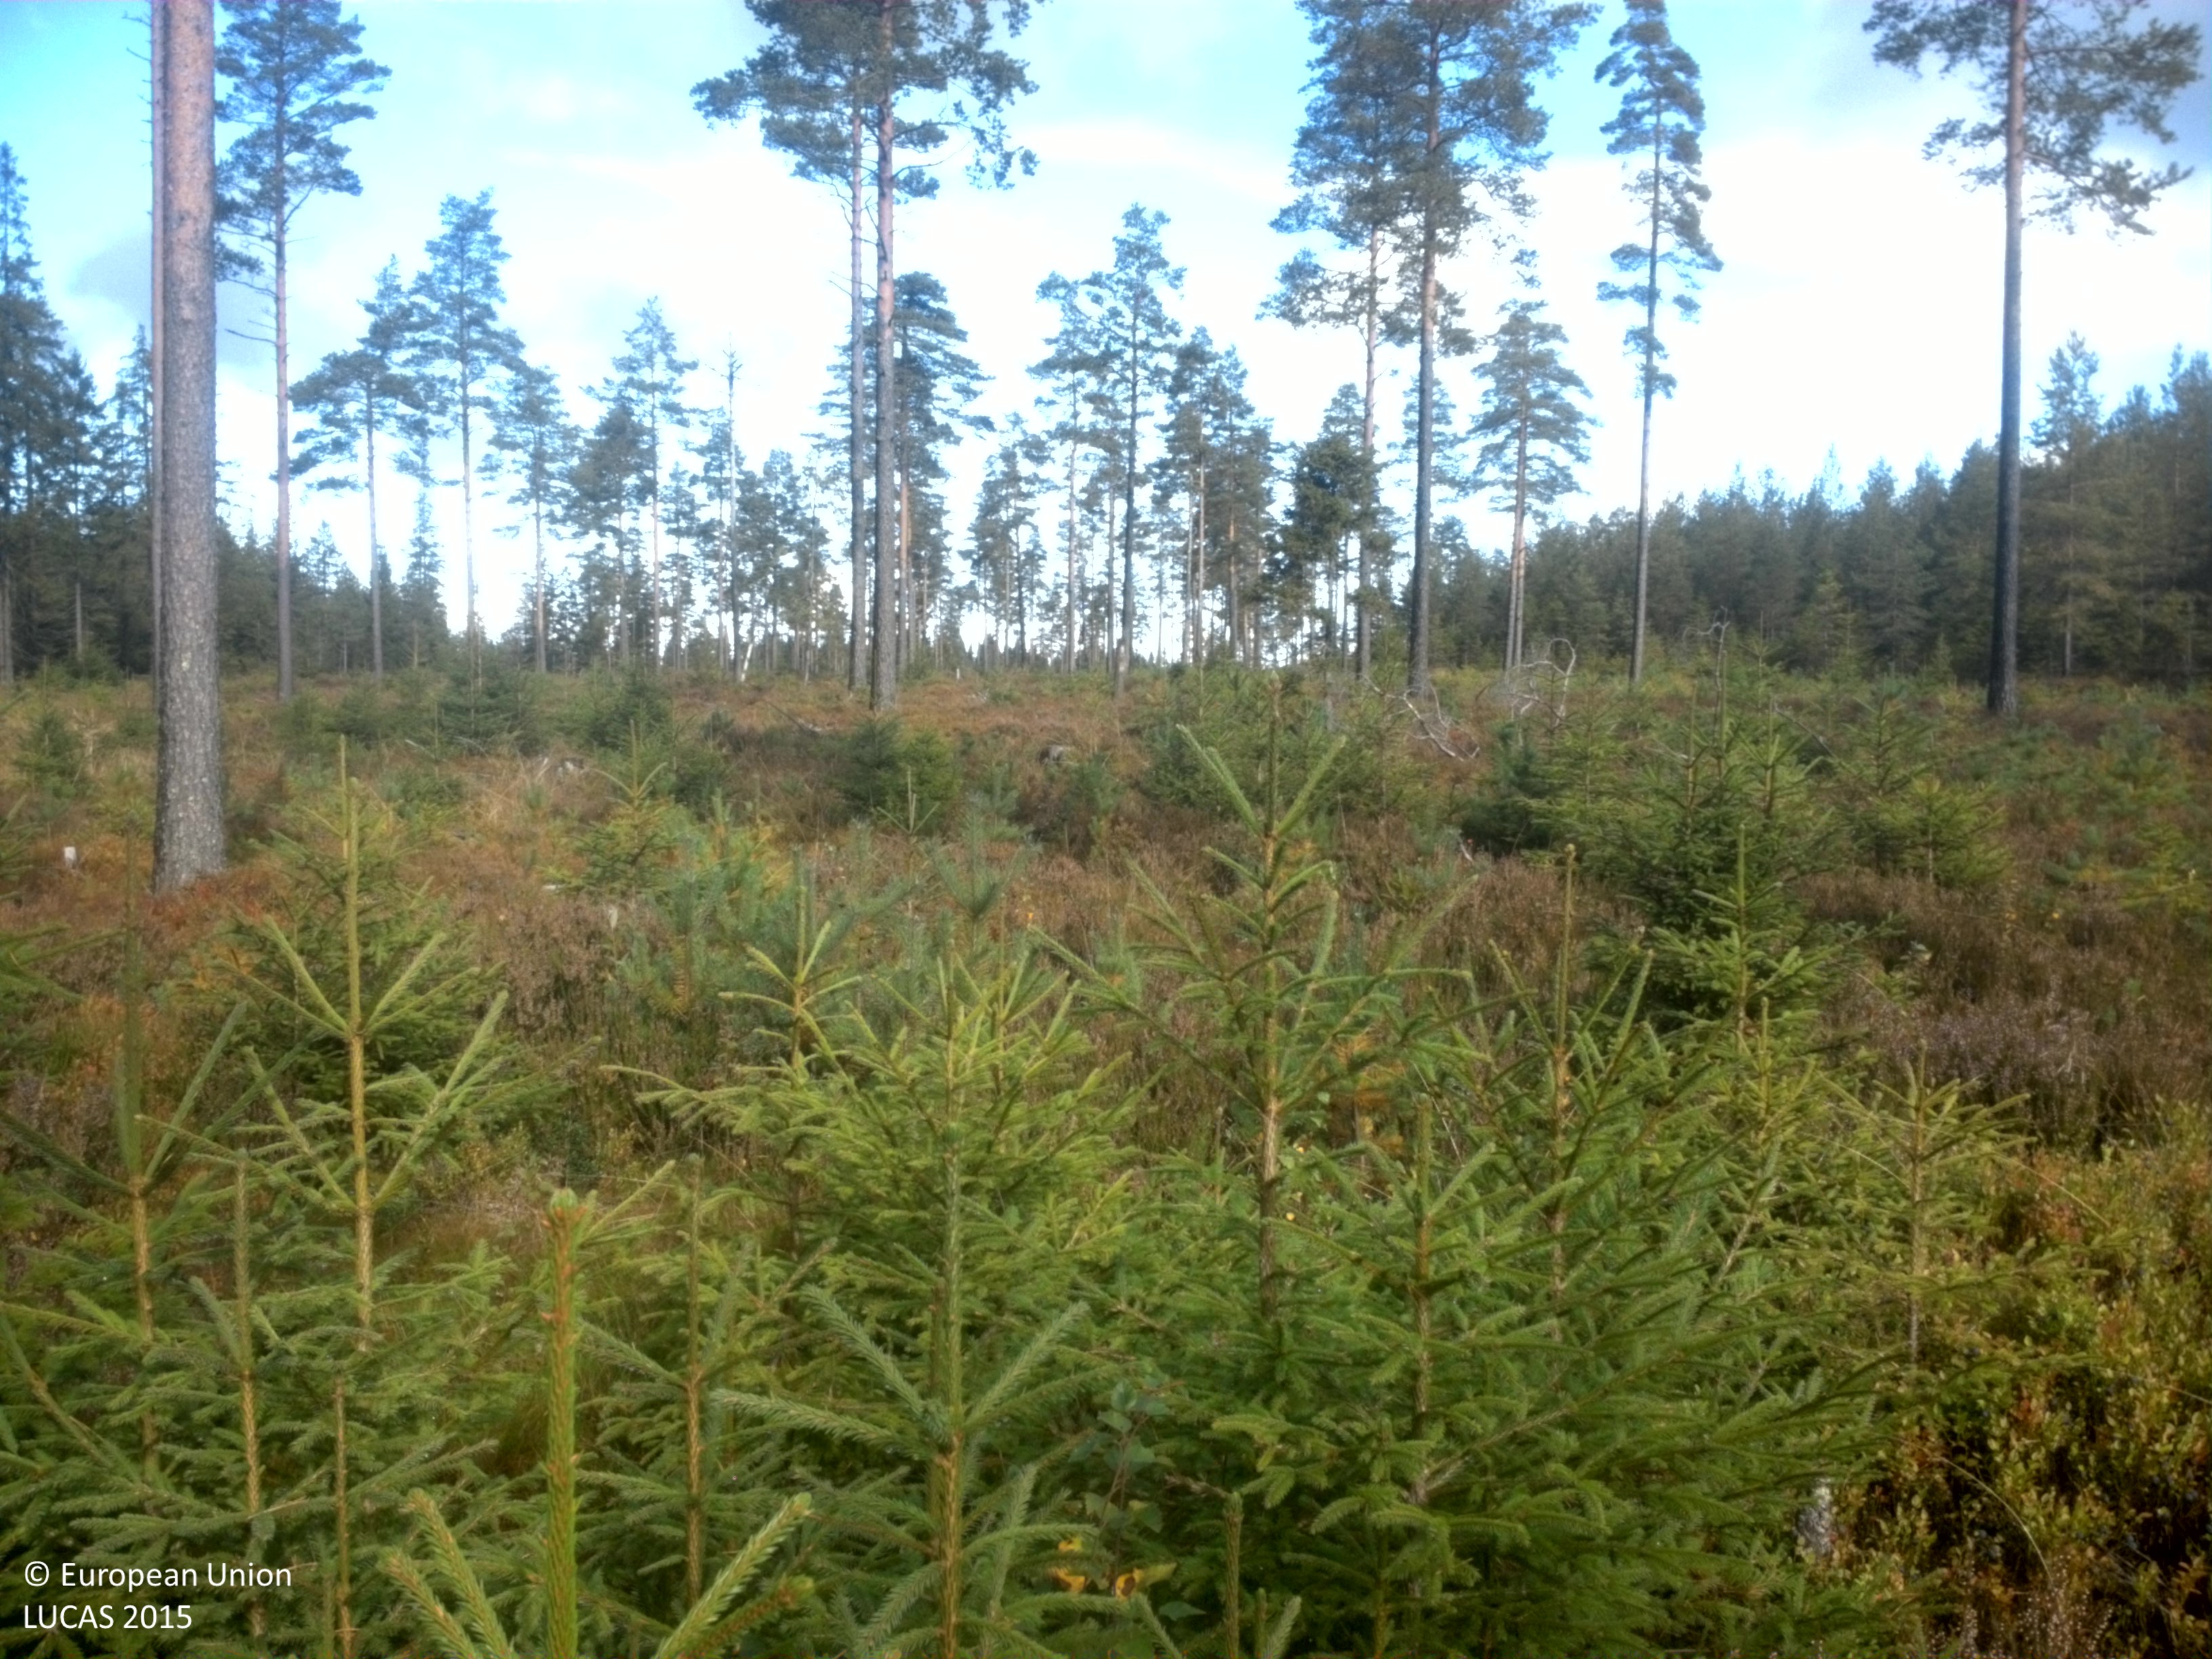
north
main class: Woodland
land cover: Other coniferous woodland
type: boreal forest
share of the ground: 50 - 75 %
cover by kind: coniferous forest trees 60 %, shrubs 30 %, herbaceous plants 10 %
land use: Forestry
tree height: > 5 m
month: September
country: SE
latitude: 59.8566
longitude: 15.5065
